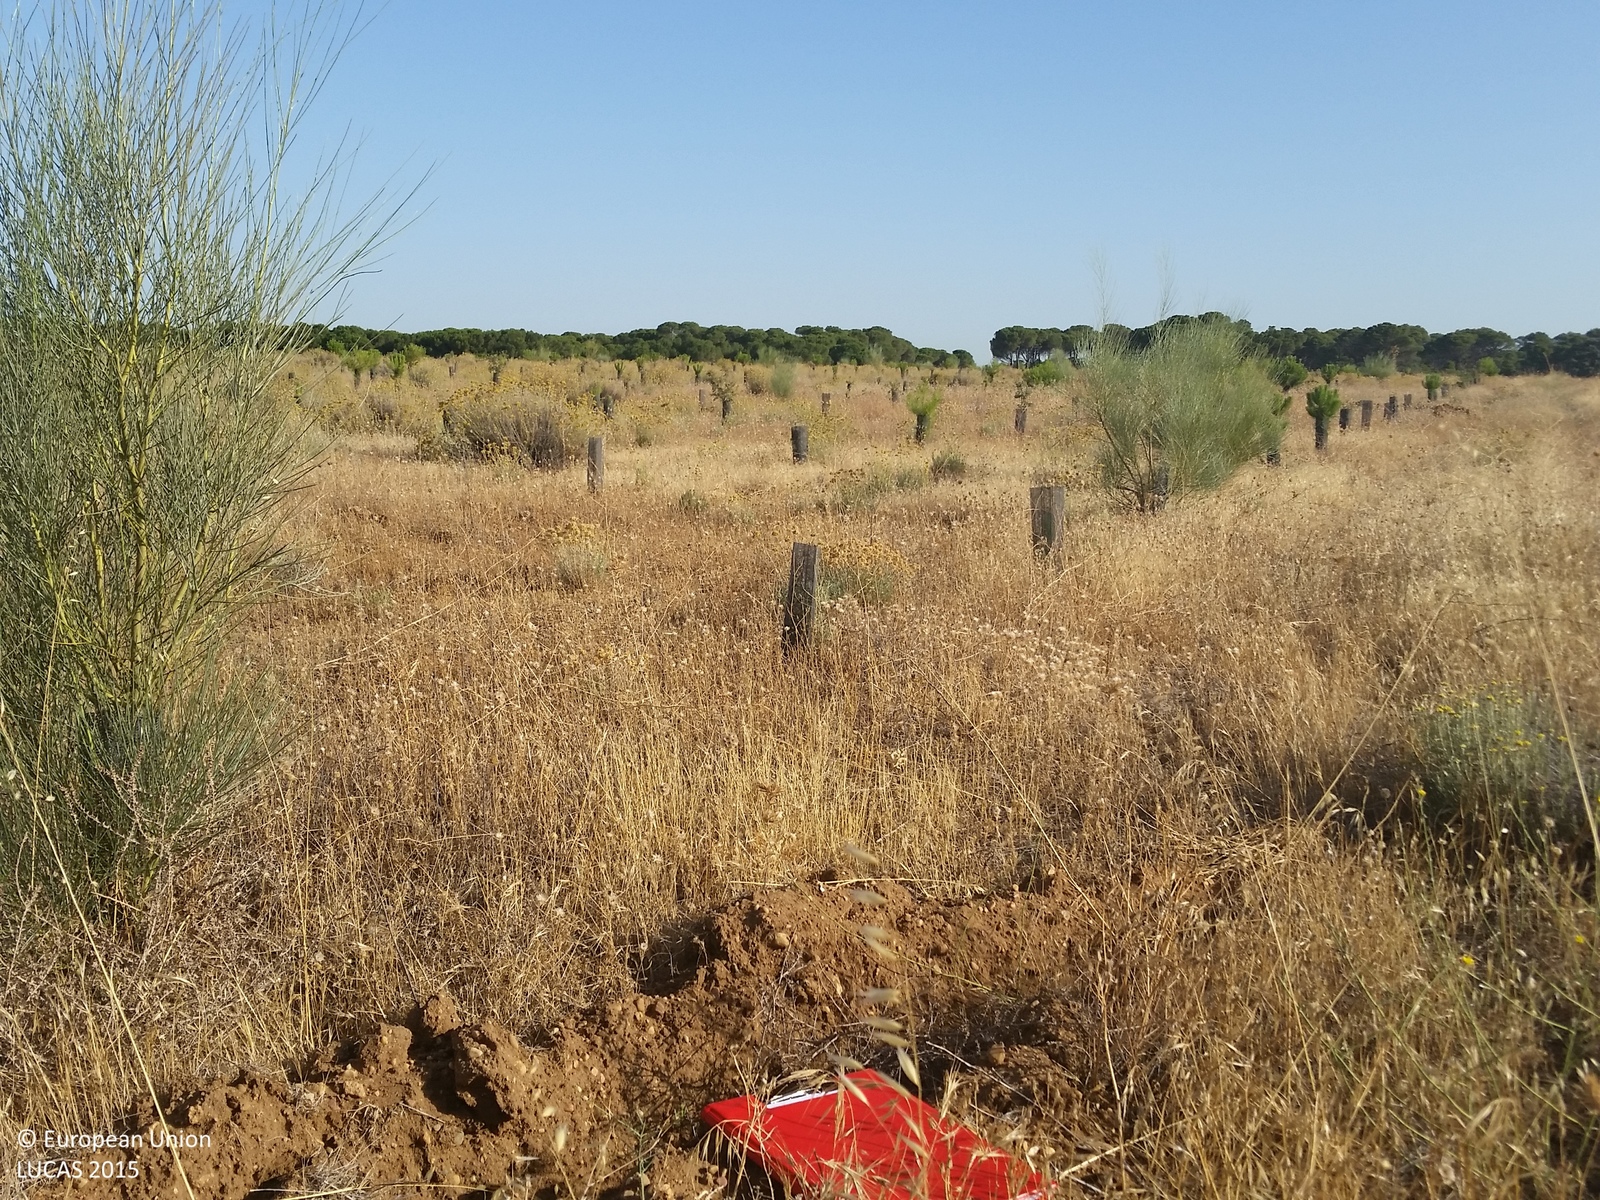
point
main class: Woodland
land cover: Pine dominated coniferous woodland
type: coniferous forest of the mediterranean region
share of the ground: 10 - 25 %
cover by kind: herbaceous plants 90 %, coniferous forest trees 10 %
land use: Forestry
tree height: < 5 m
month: July
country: ES
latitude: 39.3119
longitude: -2.6878
